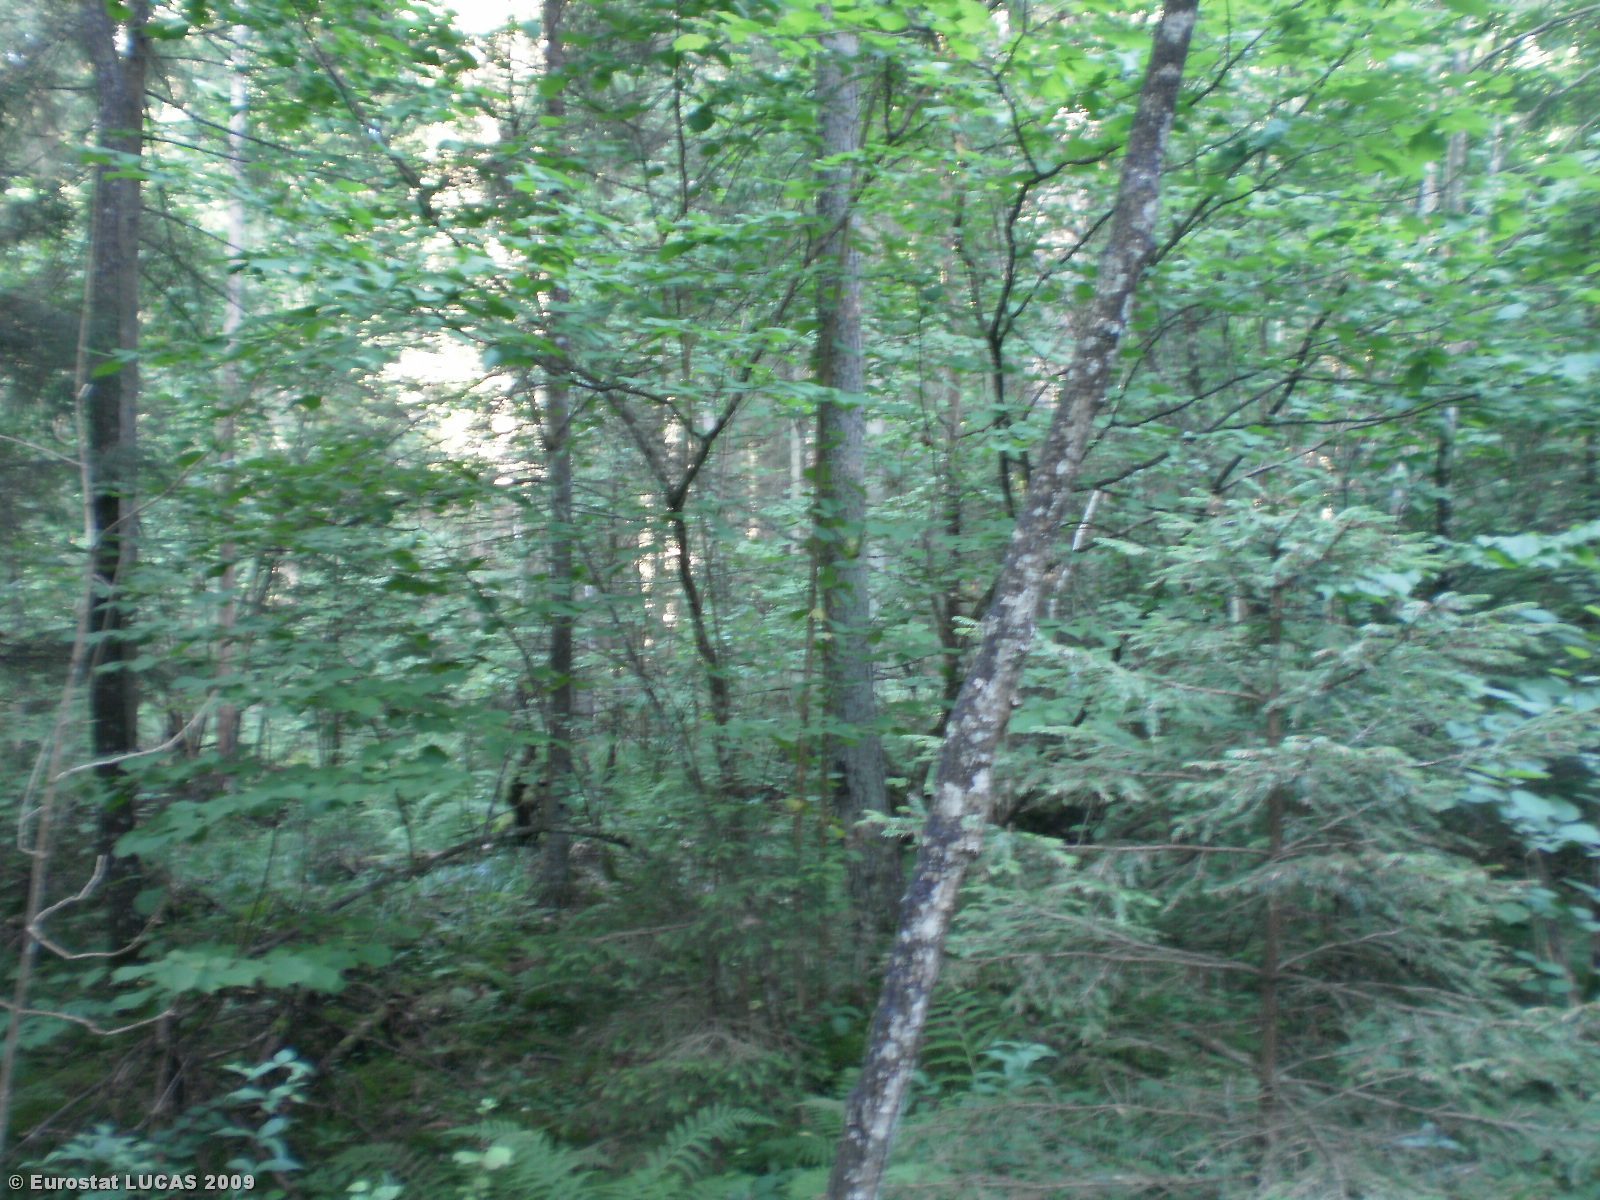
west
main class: Woodland
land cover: Mixed woodland
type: hemiboreal forest and nemoral coniferous forest and mixed broadleaved-coniferous forest
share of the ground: > 75 %
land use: Forestry
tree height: > 5 m
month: August
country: LT
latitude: 55.7079
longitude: 24.7954
